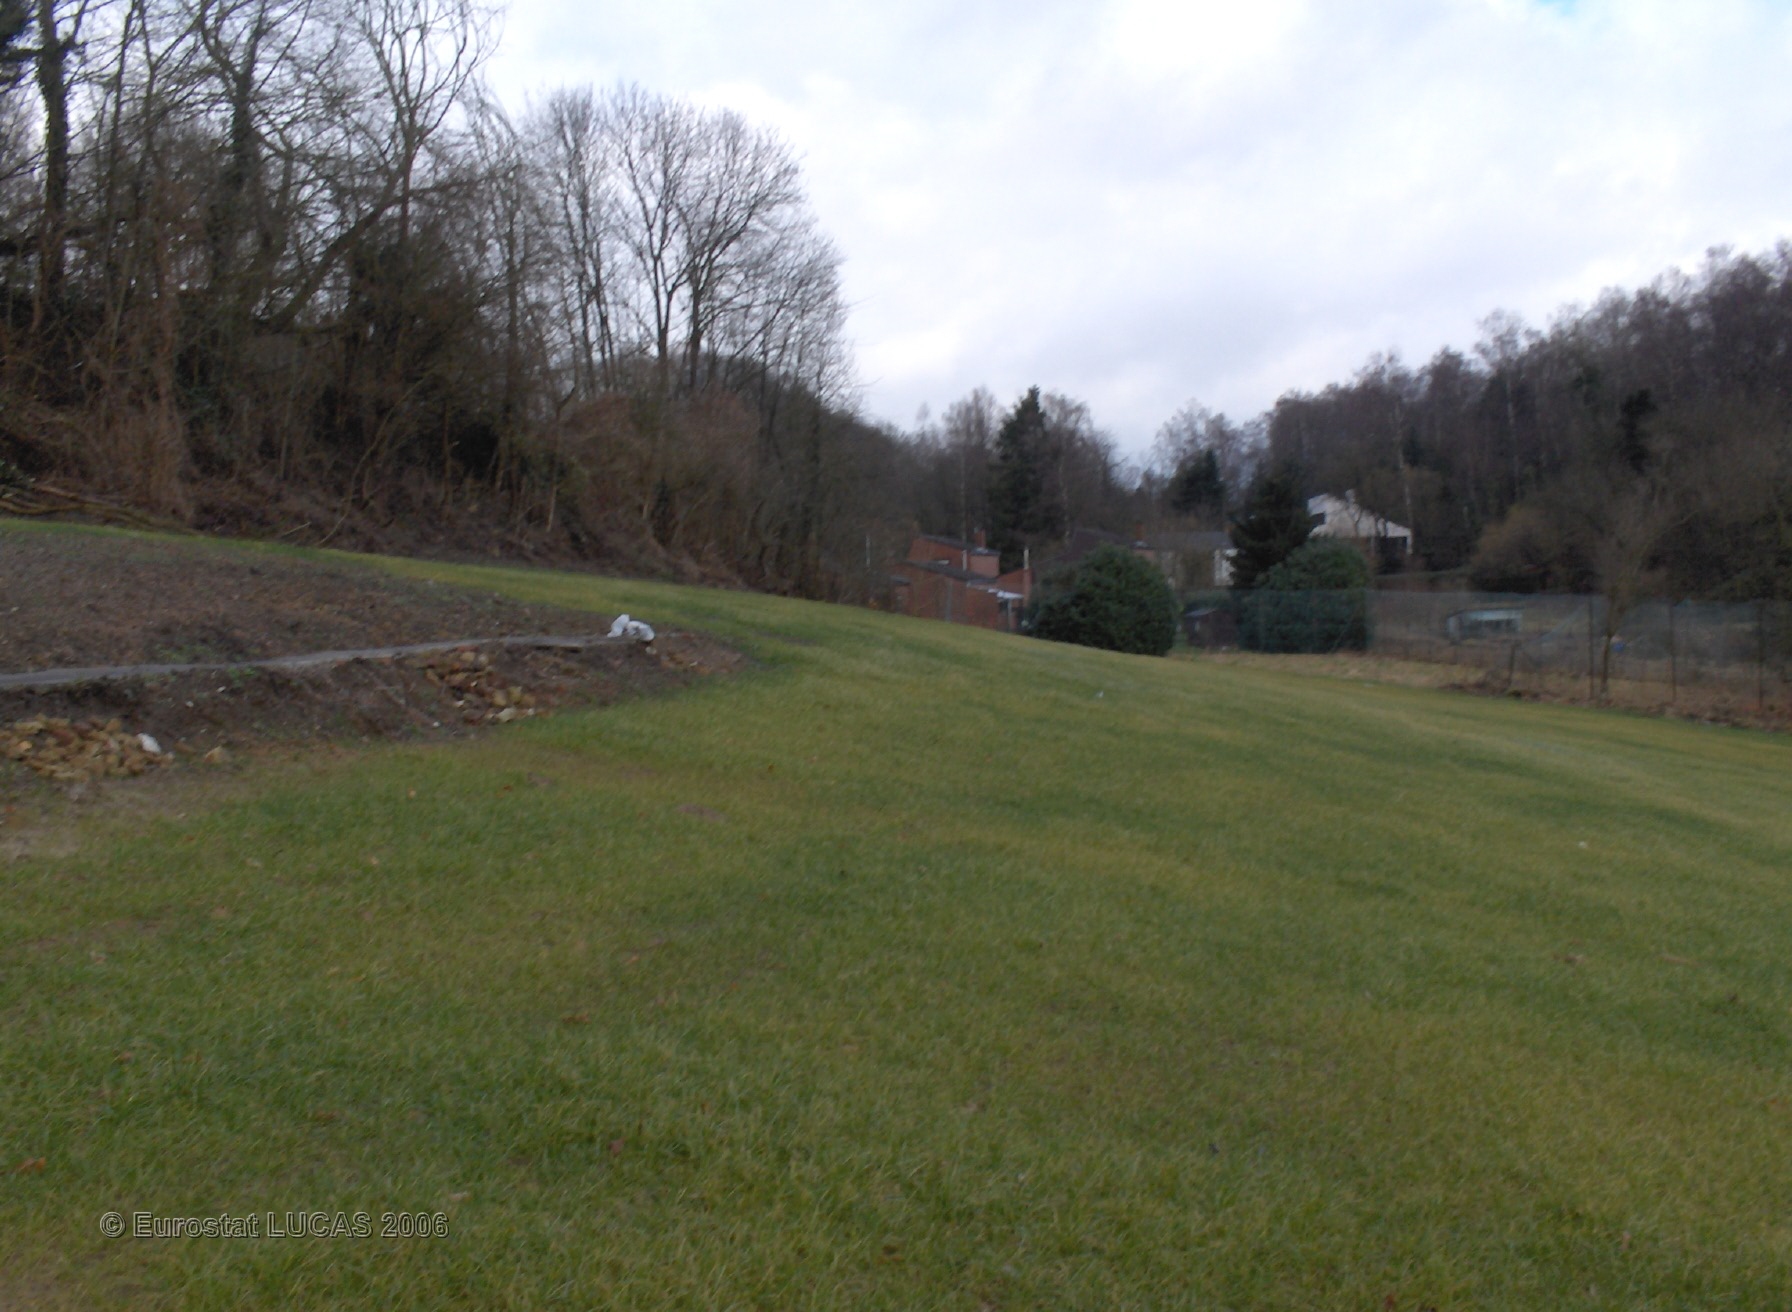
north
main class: Grassland
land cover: Grassland without tree/shrub cover
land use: Agriculture (excluding fallow land and kitchen gardens)
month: February
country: BE
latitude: 50.7728
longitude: 4.5080
